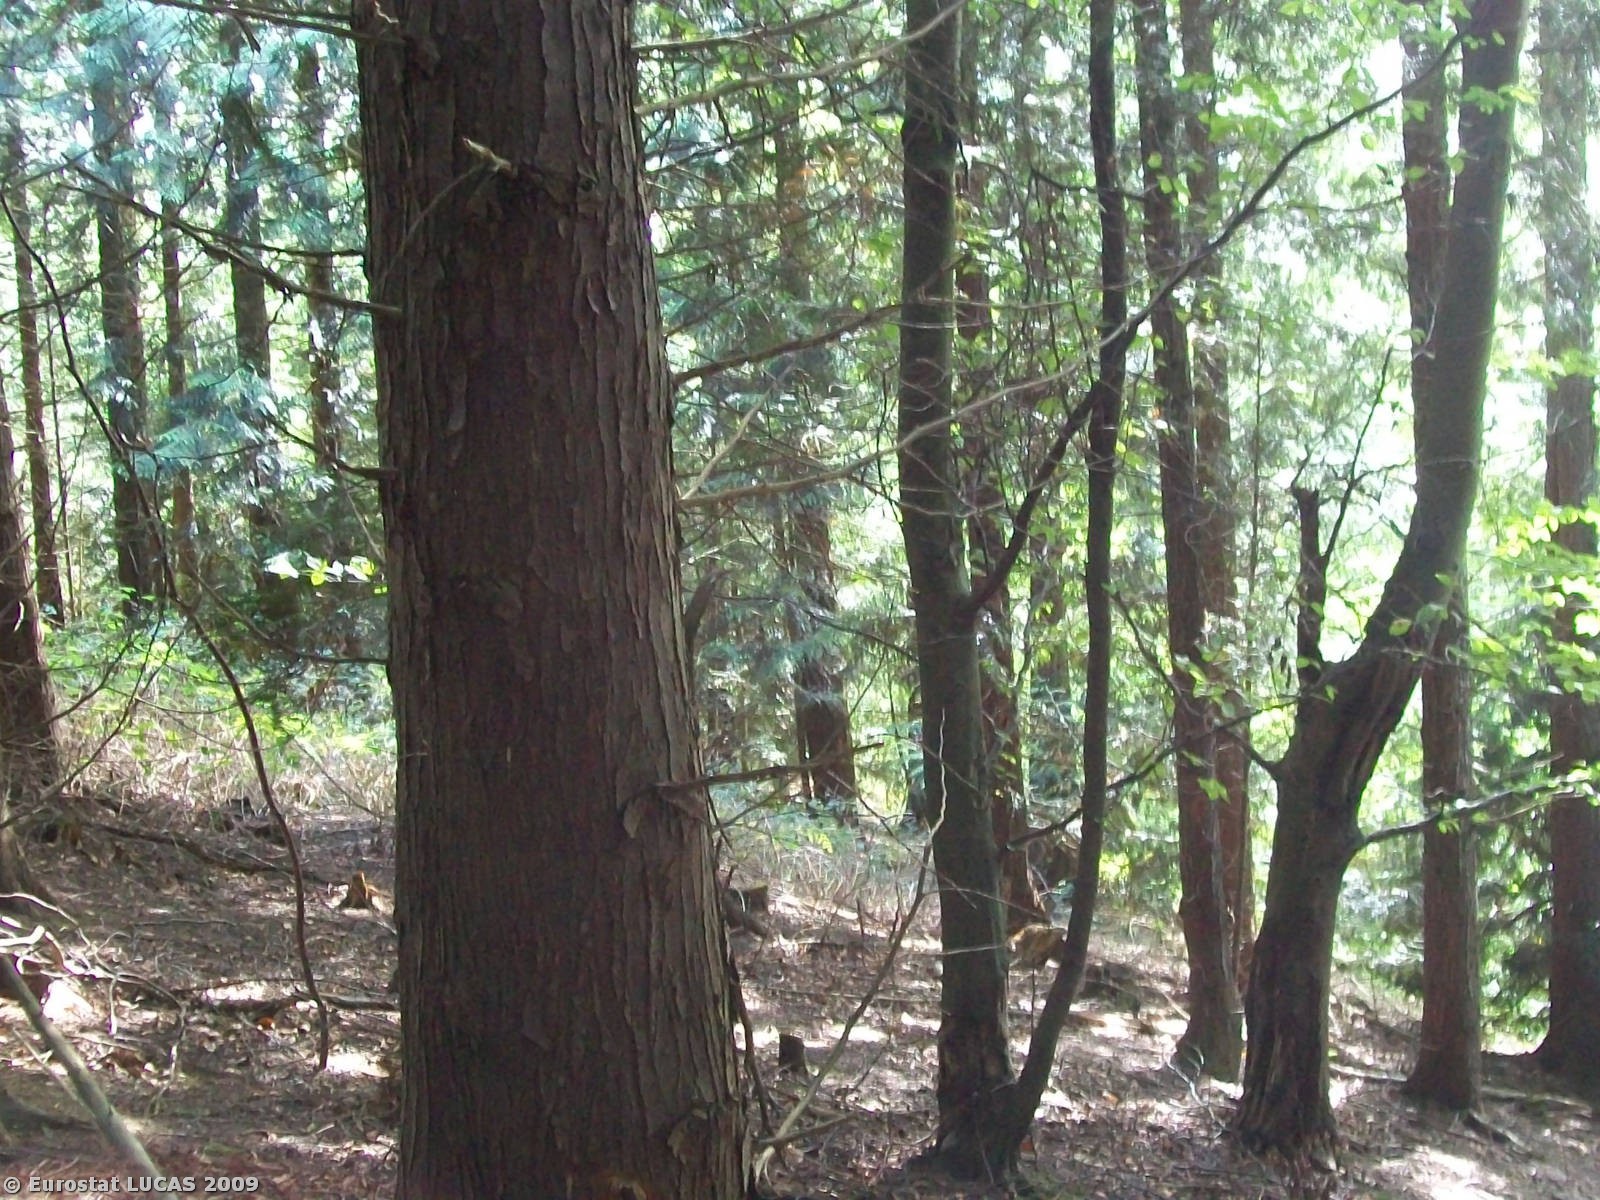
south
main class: Woodland
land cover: Coniferous woodland
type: plantations and self-sown exotic forest
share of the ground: > 75 %
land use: Community services
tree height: > 5 m
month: September
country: GB
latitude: 52.0324
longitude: -2.4112
